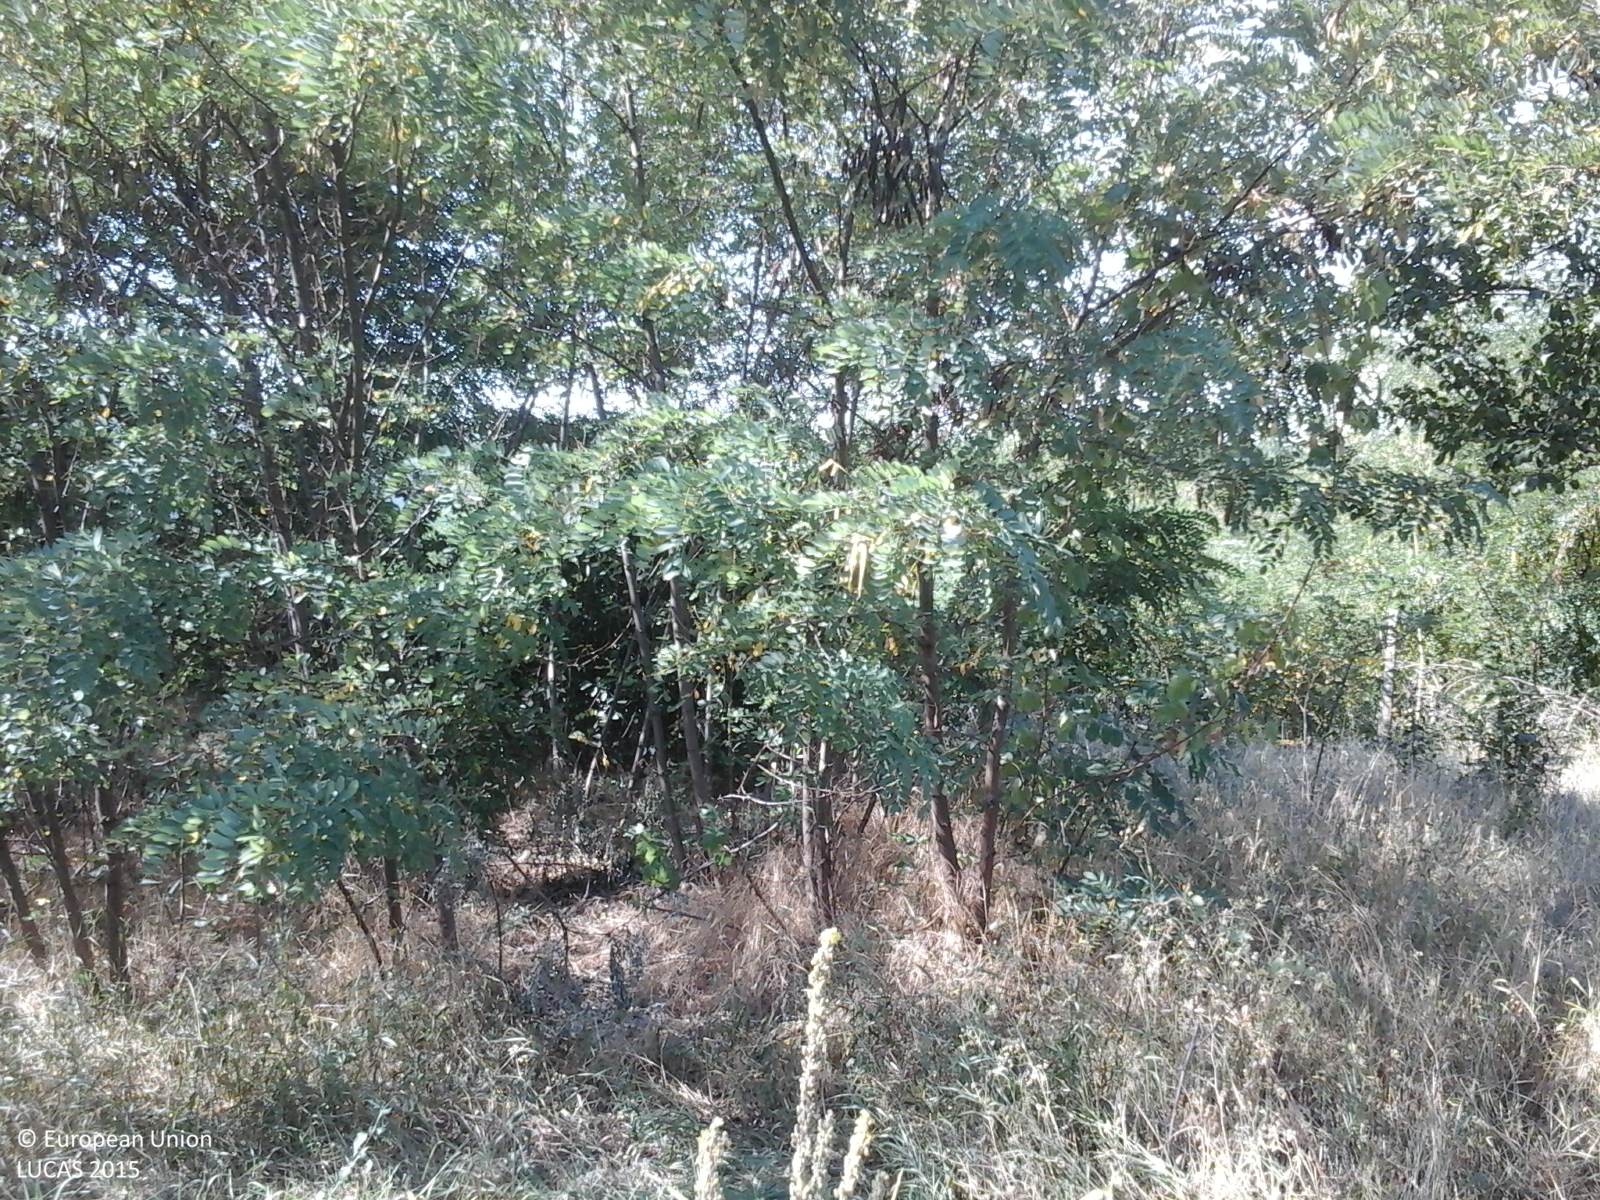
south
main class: Cropland
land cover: Vineyards
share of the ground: > 75 %
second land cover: Other bare soil
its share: > 75 %
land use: Agriculture (excluding fallow land and kitchen gardens)
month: July
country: RO
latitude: 46.3441
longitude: 27.8562
